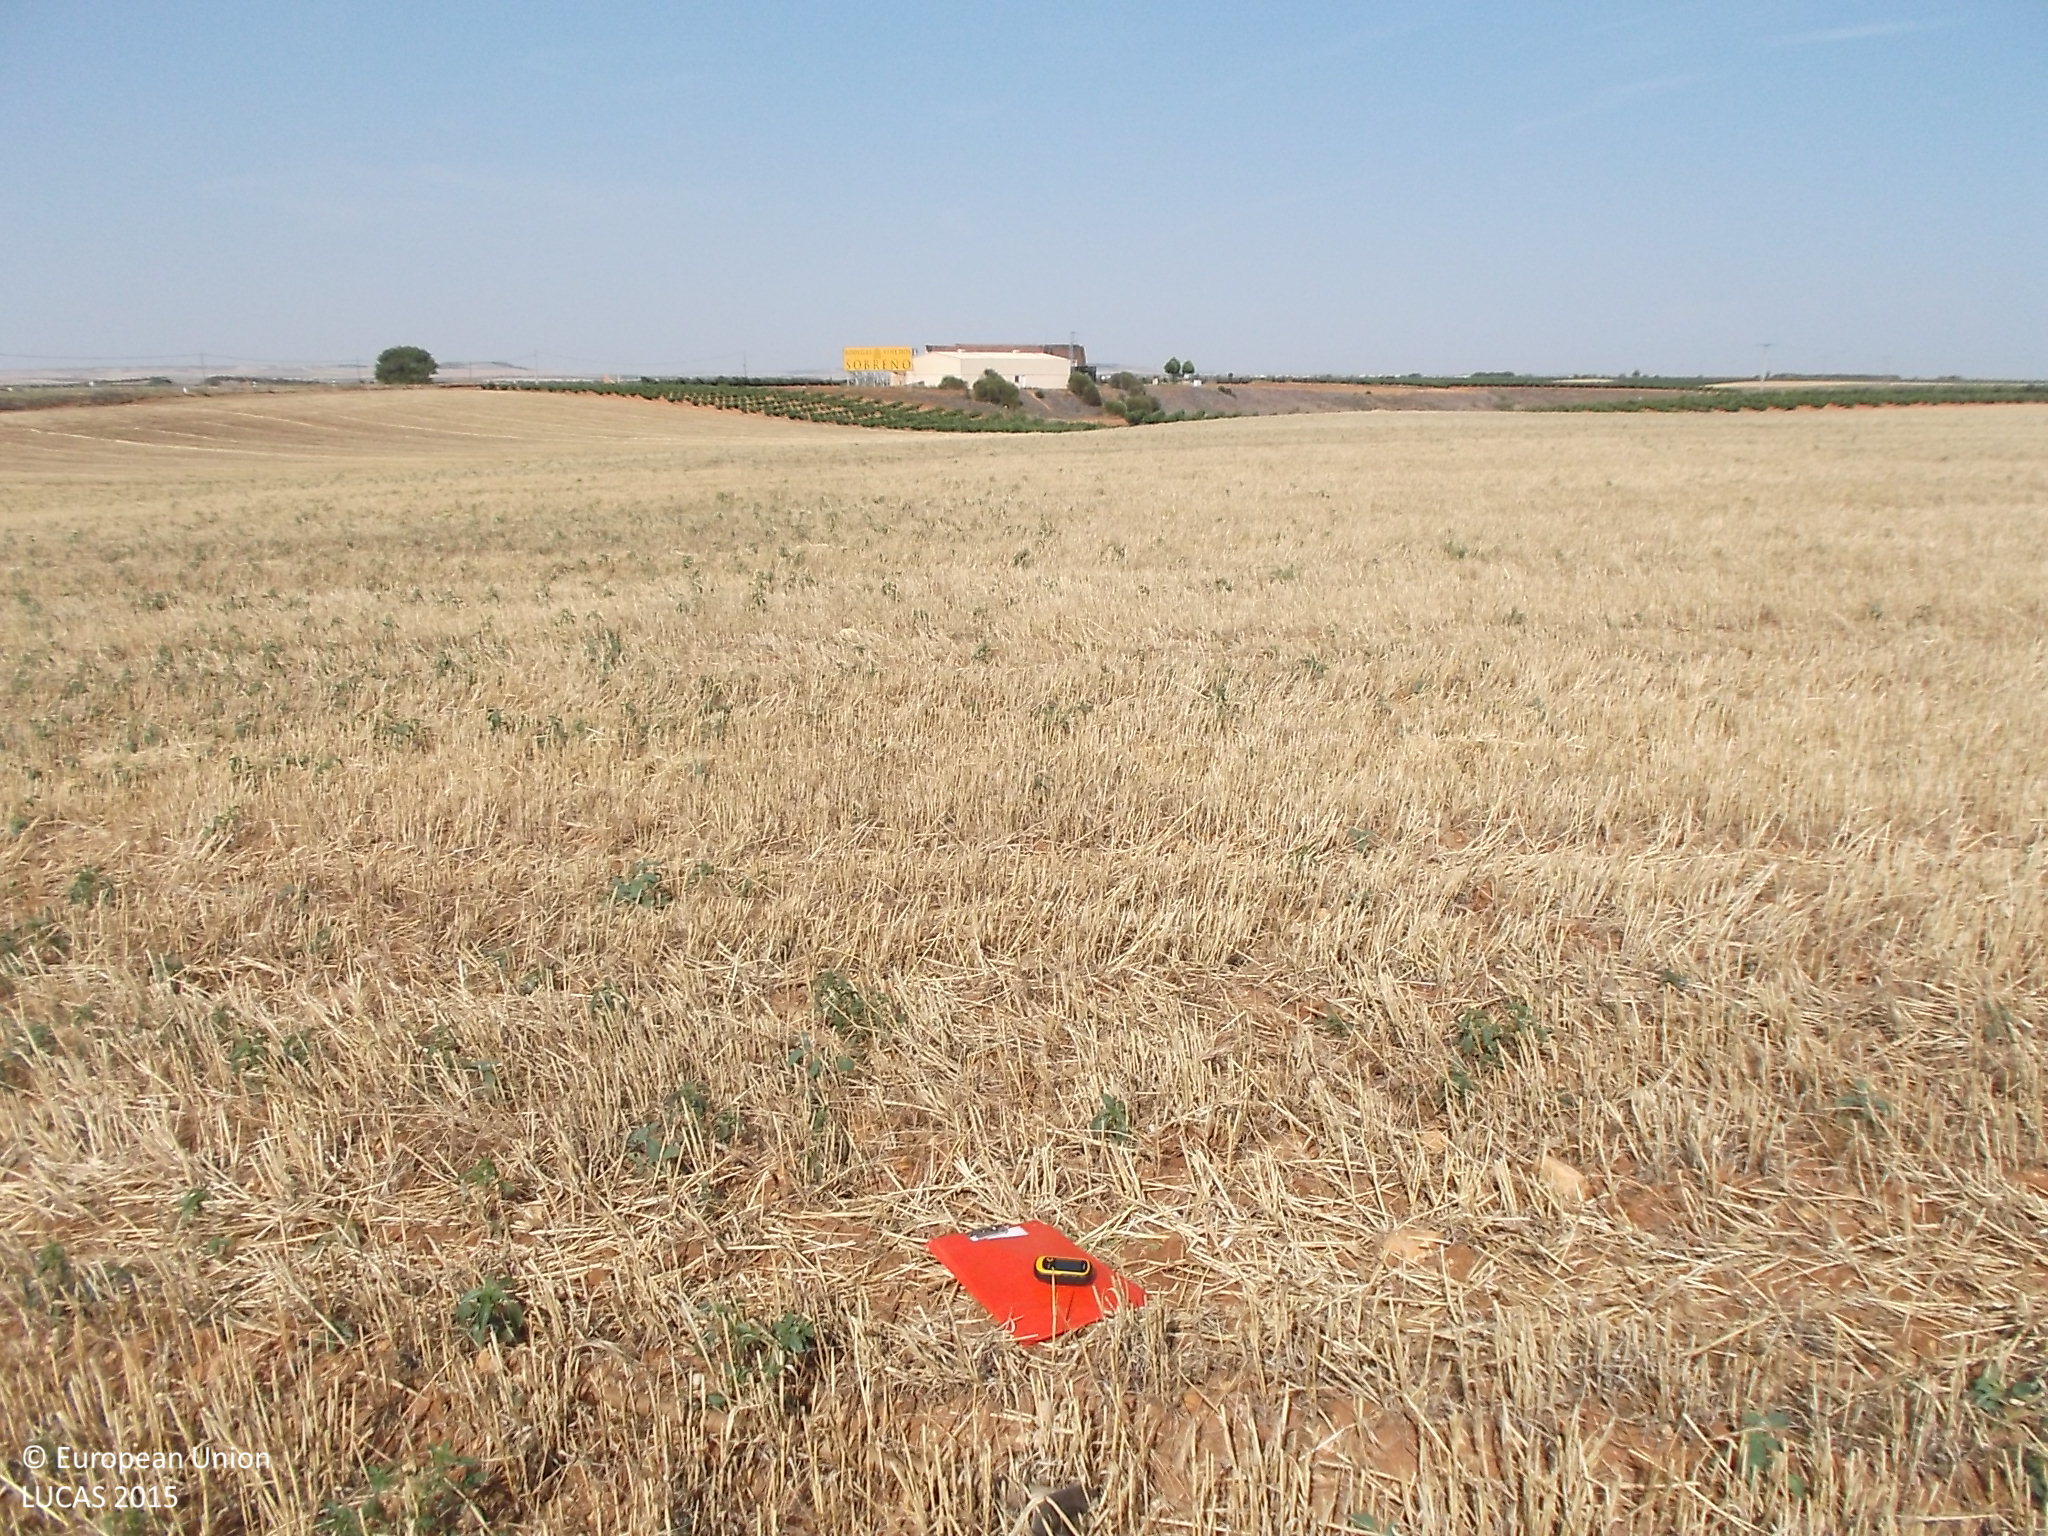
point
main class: Cropland
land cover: Barley
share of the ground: < 10 %
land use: Agriculture (excluding fallow land and kitchen gardens)
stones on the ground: < 10 %
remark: Harvested field
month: July
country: ES
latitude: 41.5294
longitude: -5.3599
